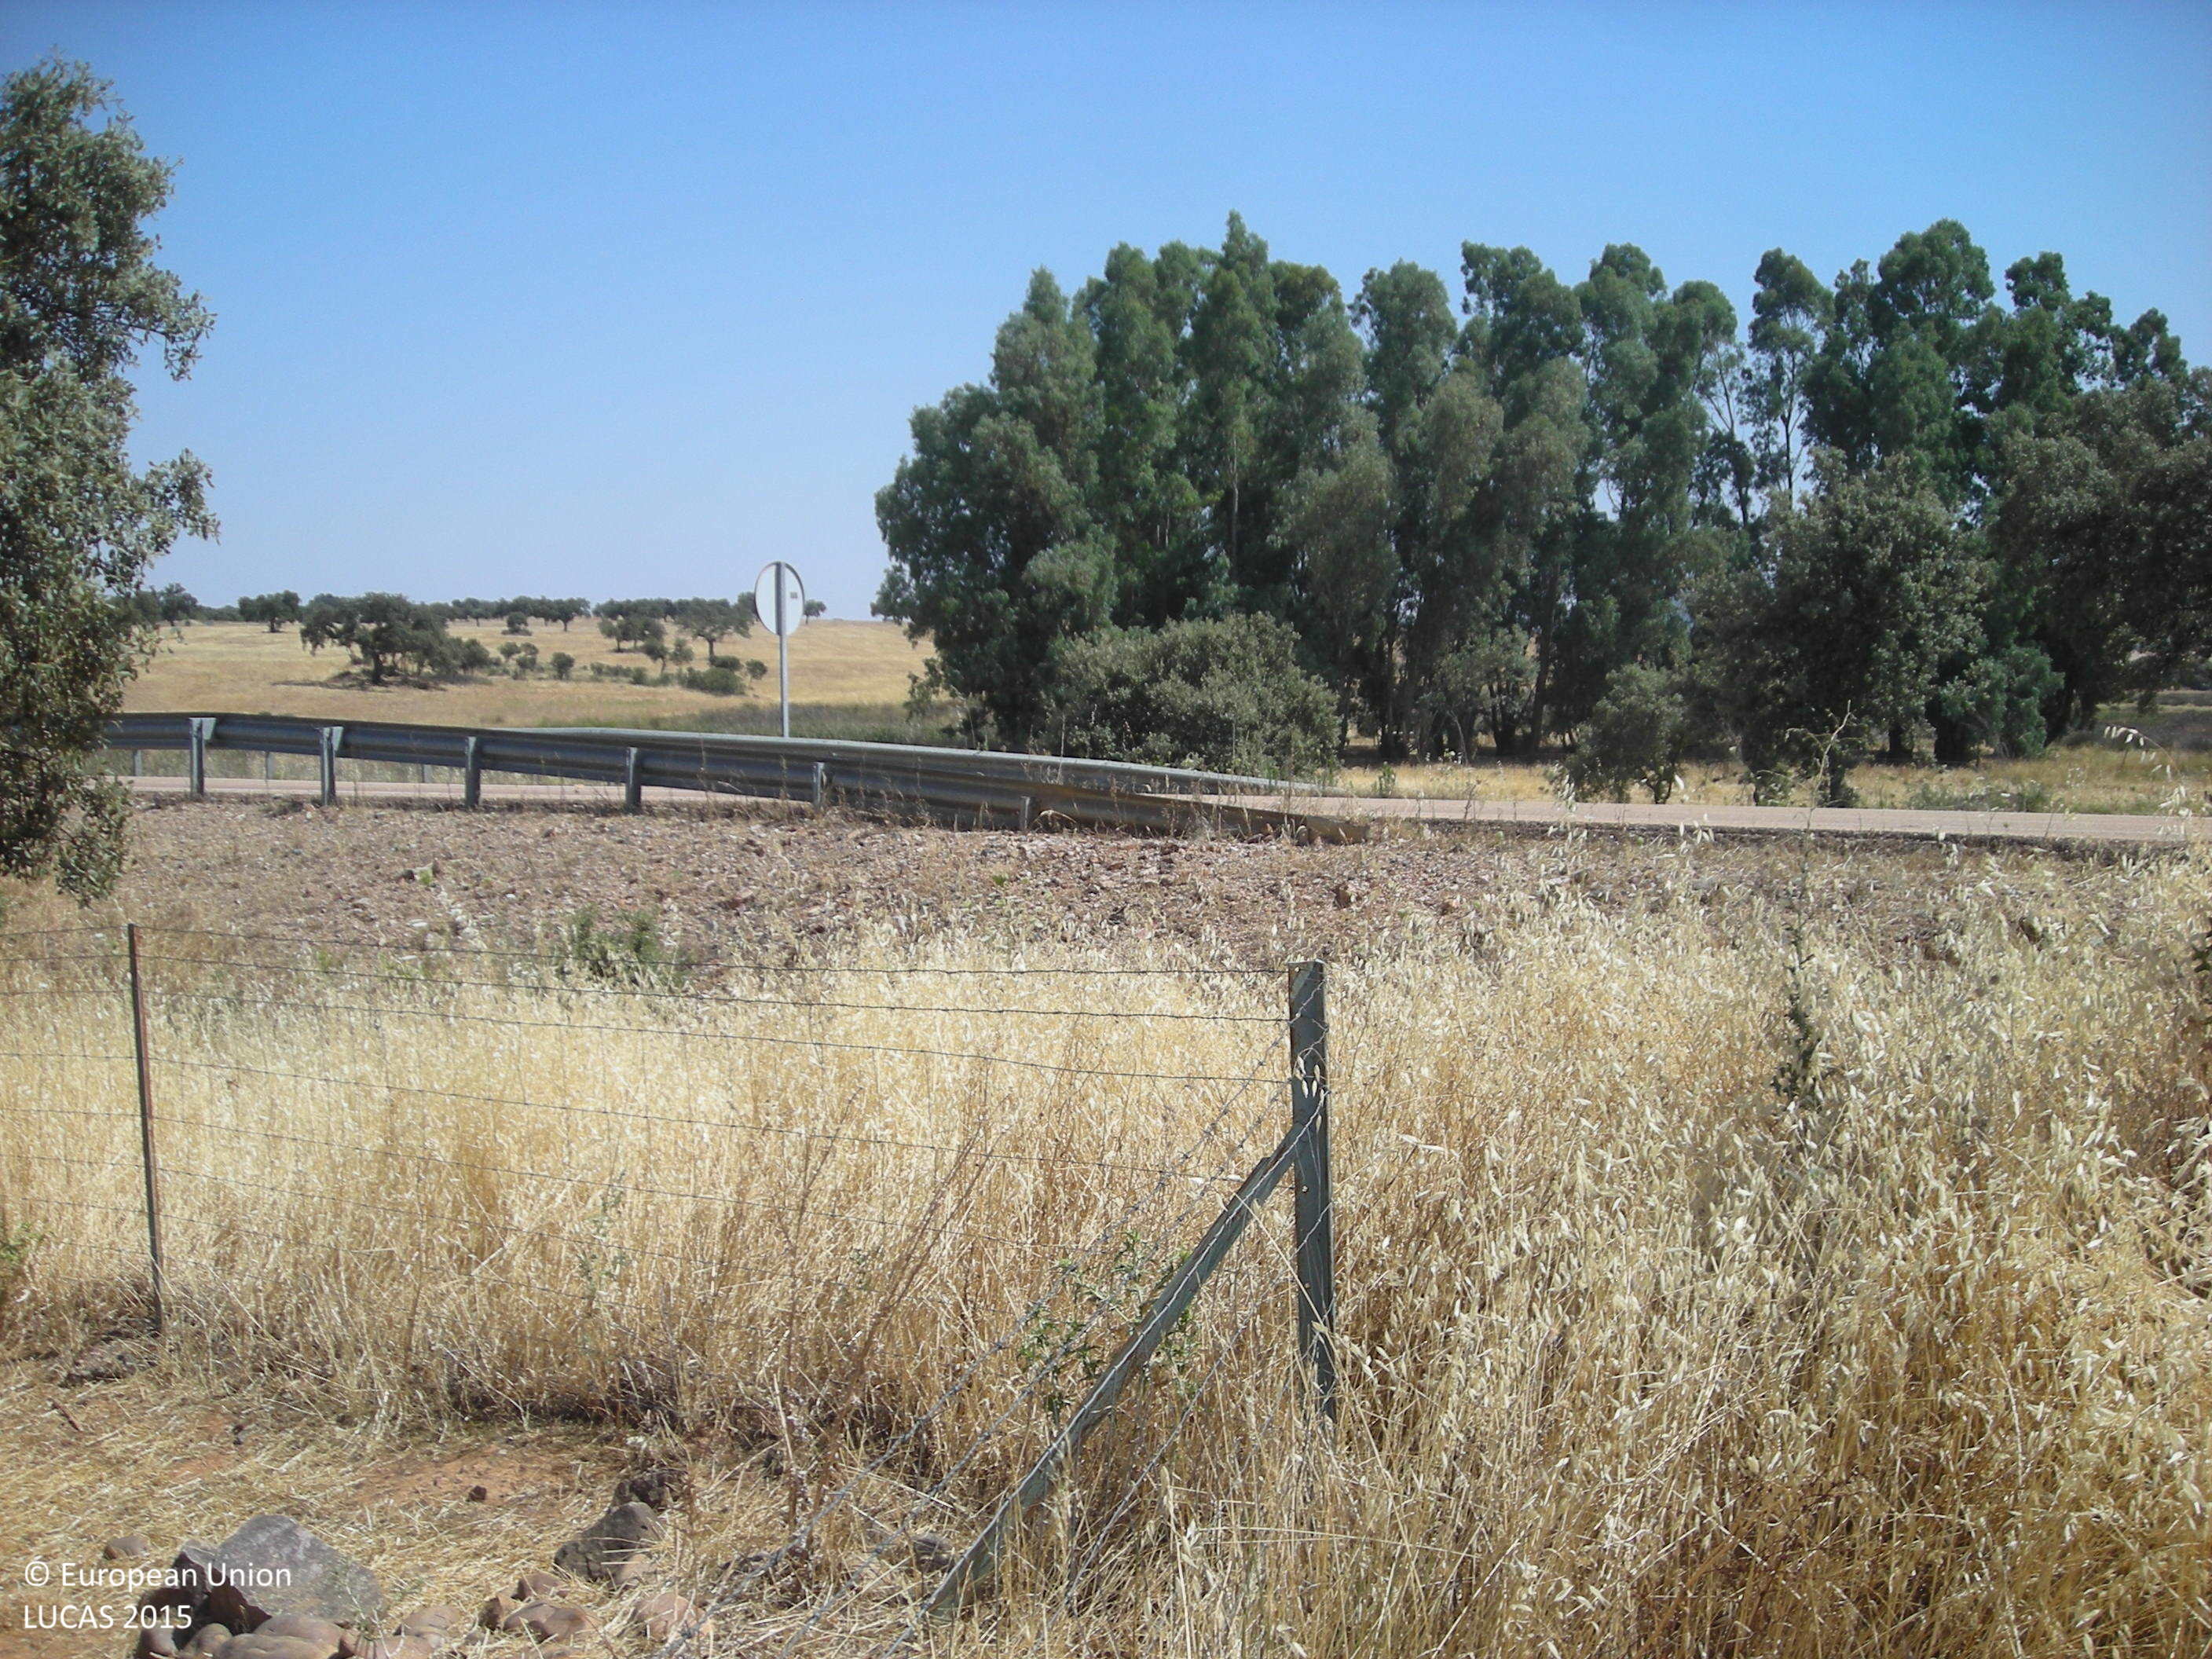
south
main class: Grassland
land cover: Grassland with sparse tree/shrub cover
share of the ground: > 75 %
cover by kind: herbaceous plants 85 %, shrubs 10 %, broadleaved forest trees 5 %
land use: Agriculture (excluding fallow land and kitchen gardens)
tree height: > 5 m
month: June
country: ES
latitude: 38.6362
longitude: -5.8630
